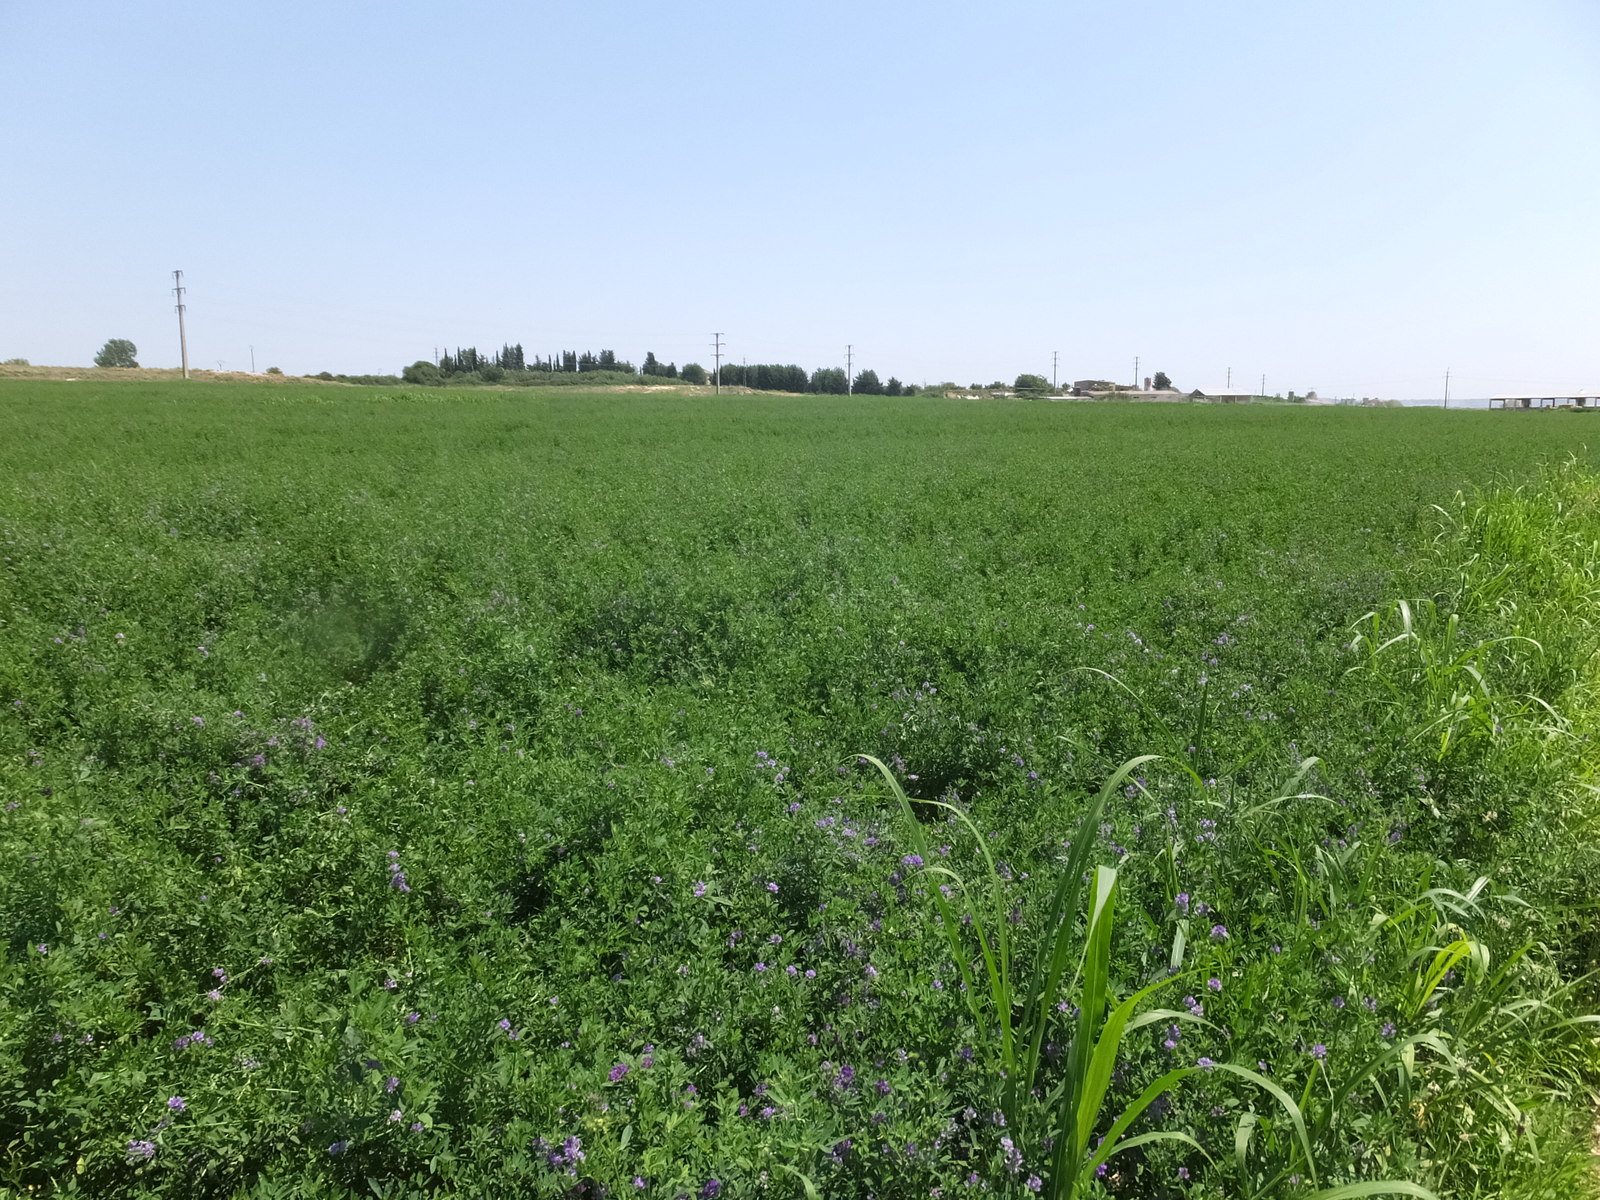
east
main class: Cropland
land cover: Lucerne
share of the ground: > 75 %
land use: Agriculture (excluding fallow land and kitchen gardens)
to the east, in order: Lucerne
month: June
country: ES
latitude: 41.7965
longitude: 0.3936
